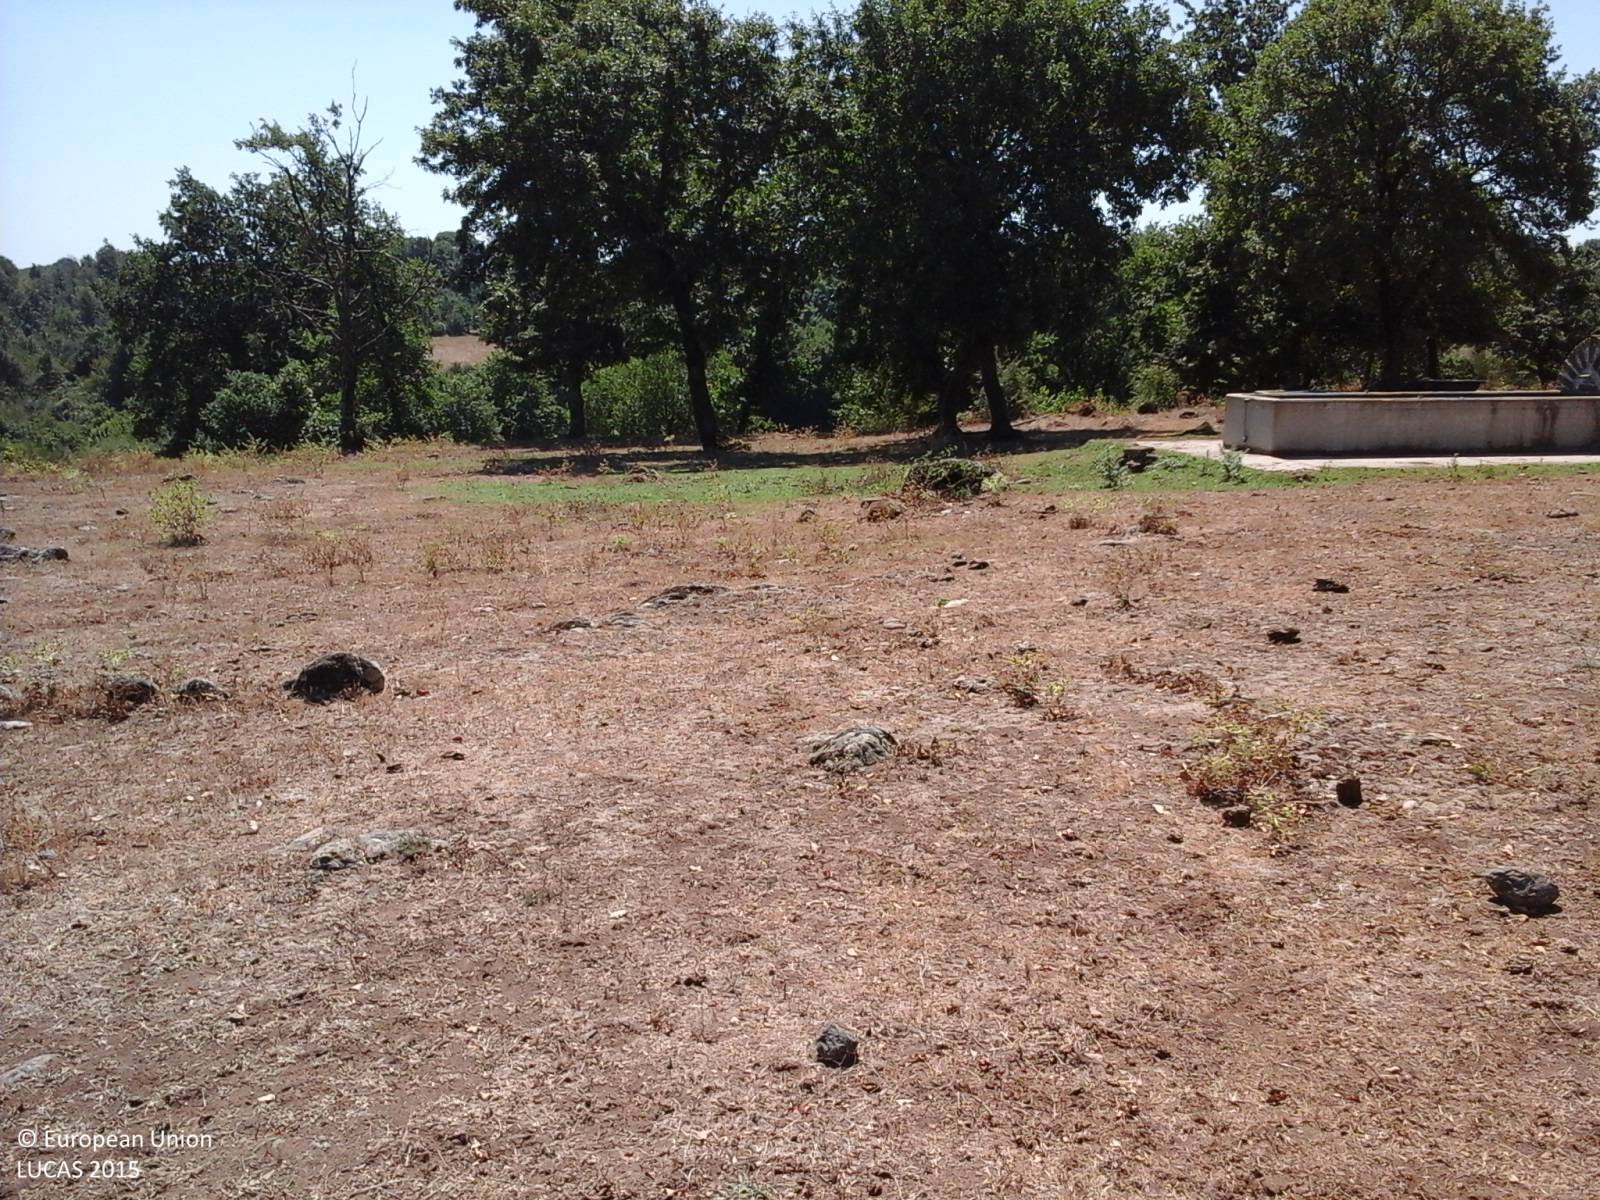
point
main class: Grassland
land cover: Grassland with sparse tree/shrub cover
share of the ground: > 75 %
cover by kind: herbaceous plants 60 %, unconsolidated bare surface 35 %, broadleaved forest trees 5 %
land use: Agriculture (excluding fallow land and kitchen gardens)
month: July
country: IT
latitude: 42.2116
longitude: 12.3296
